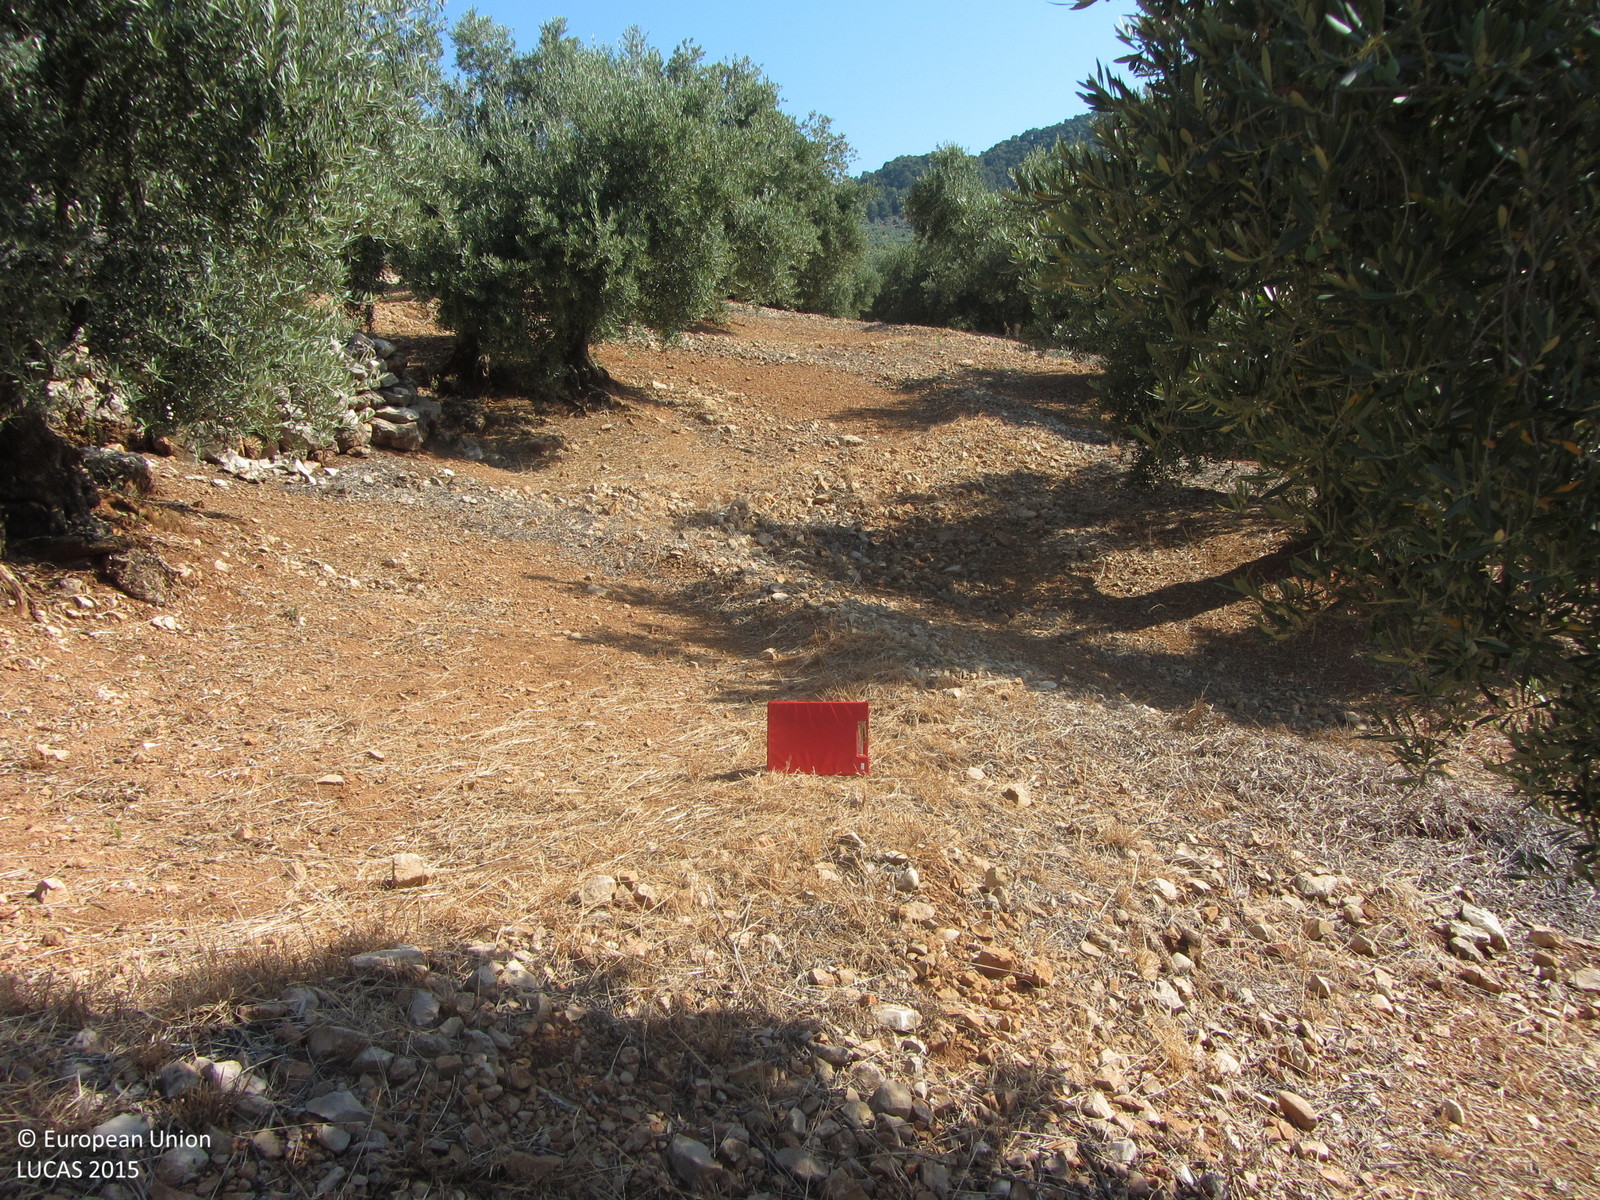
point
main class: Cropland
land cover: Olive groves
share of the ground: 25 - 50 %
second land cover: Other bare soil
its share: > 75 %
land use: Agriculture (excluding fallow land and kitchen gardens)
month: June
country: ES
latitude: 38.2014
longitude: -2.9137
